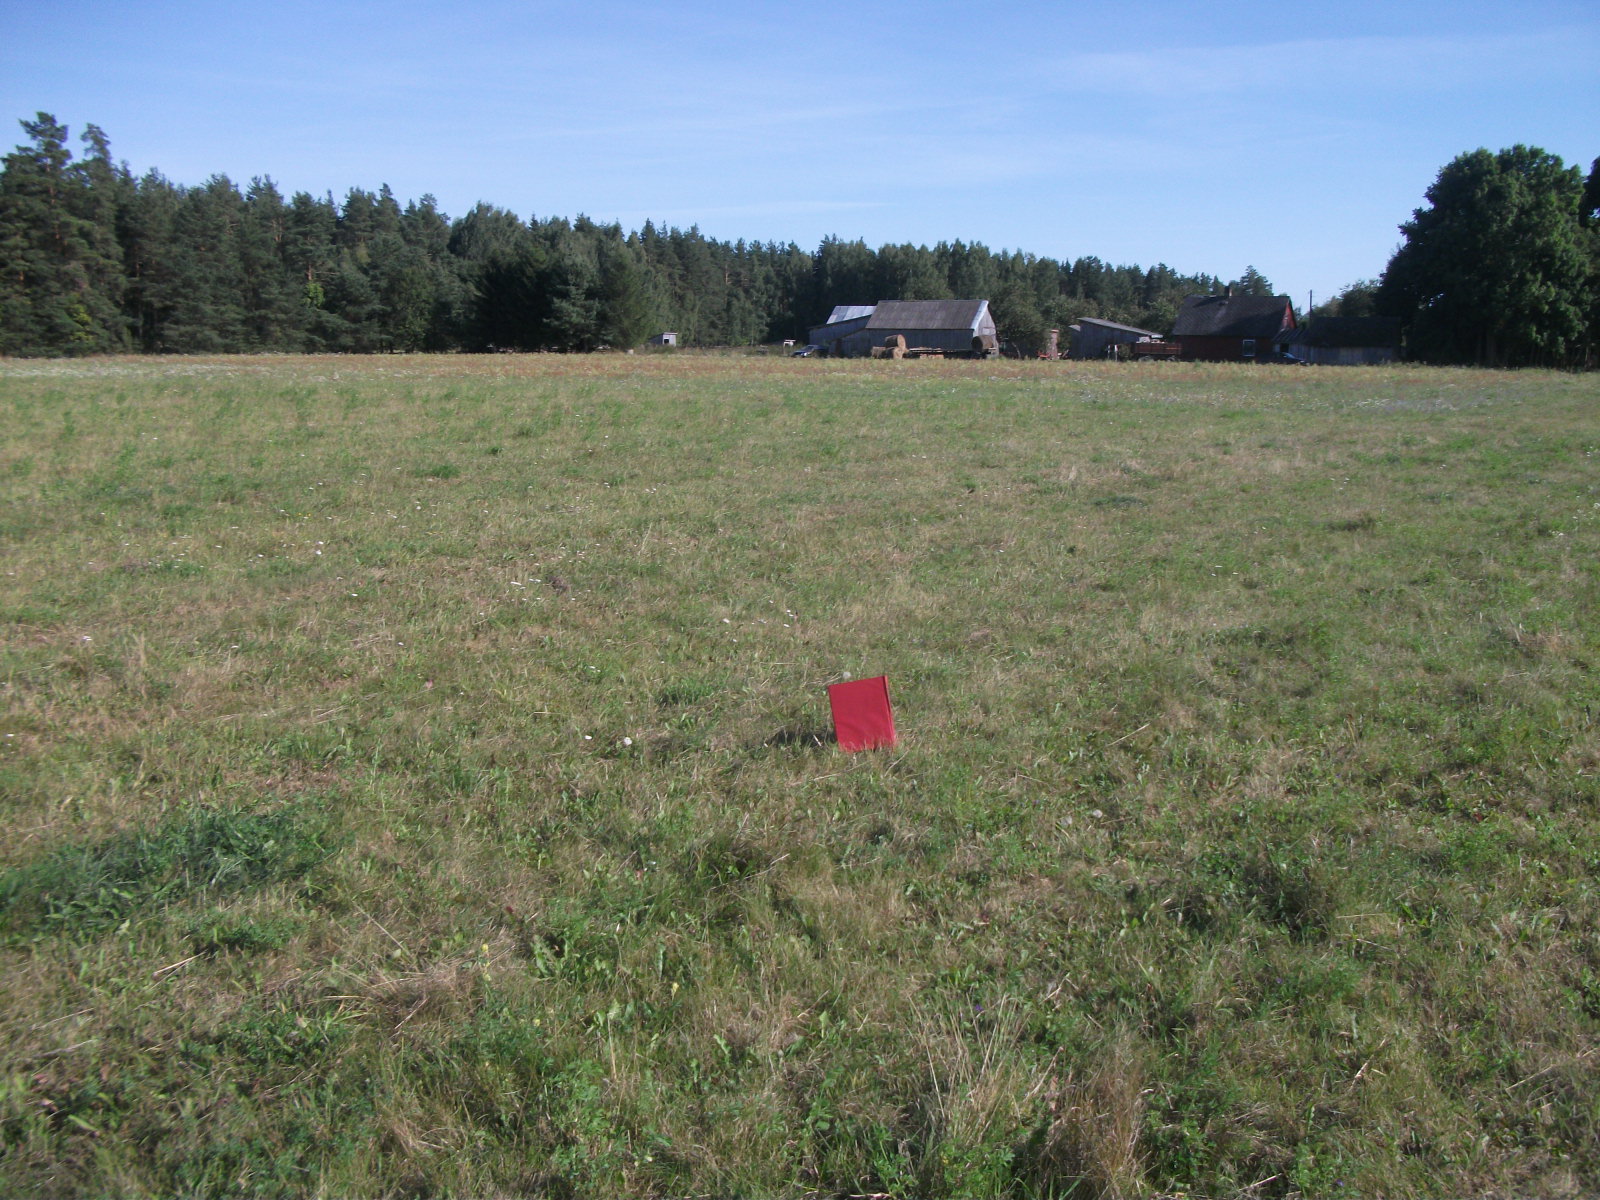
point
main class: Grassland
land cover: Grassland without tree/shrub cover
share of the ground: > 75 %
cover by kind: herbaceous plants 100 %
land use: Agriculture (excluding fallow land and kitchen gardens)
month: August
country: LV
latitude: 56.3077
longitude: 26.1902
